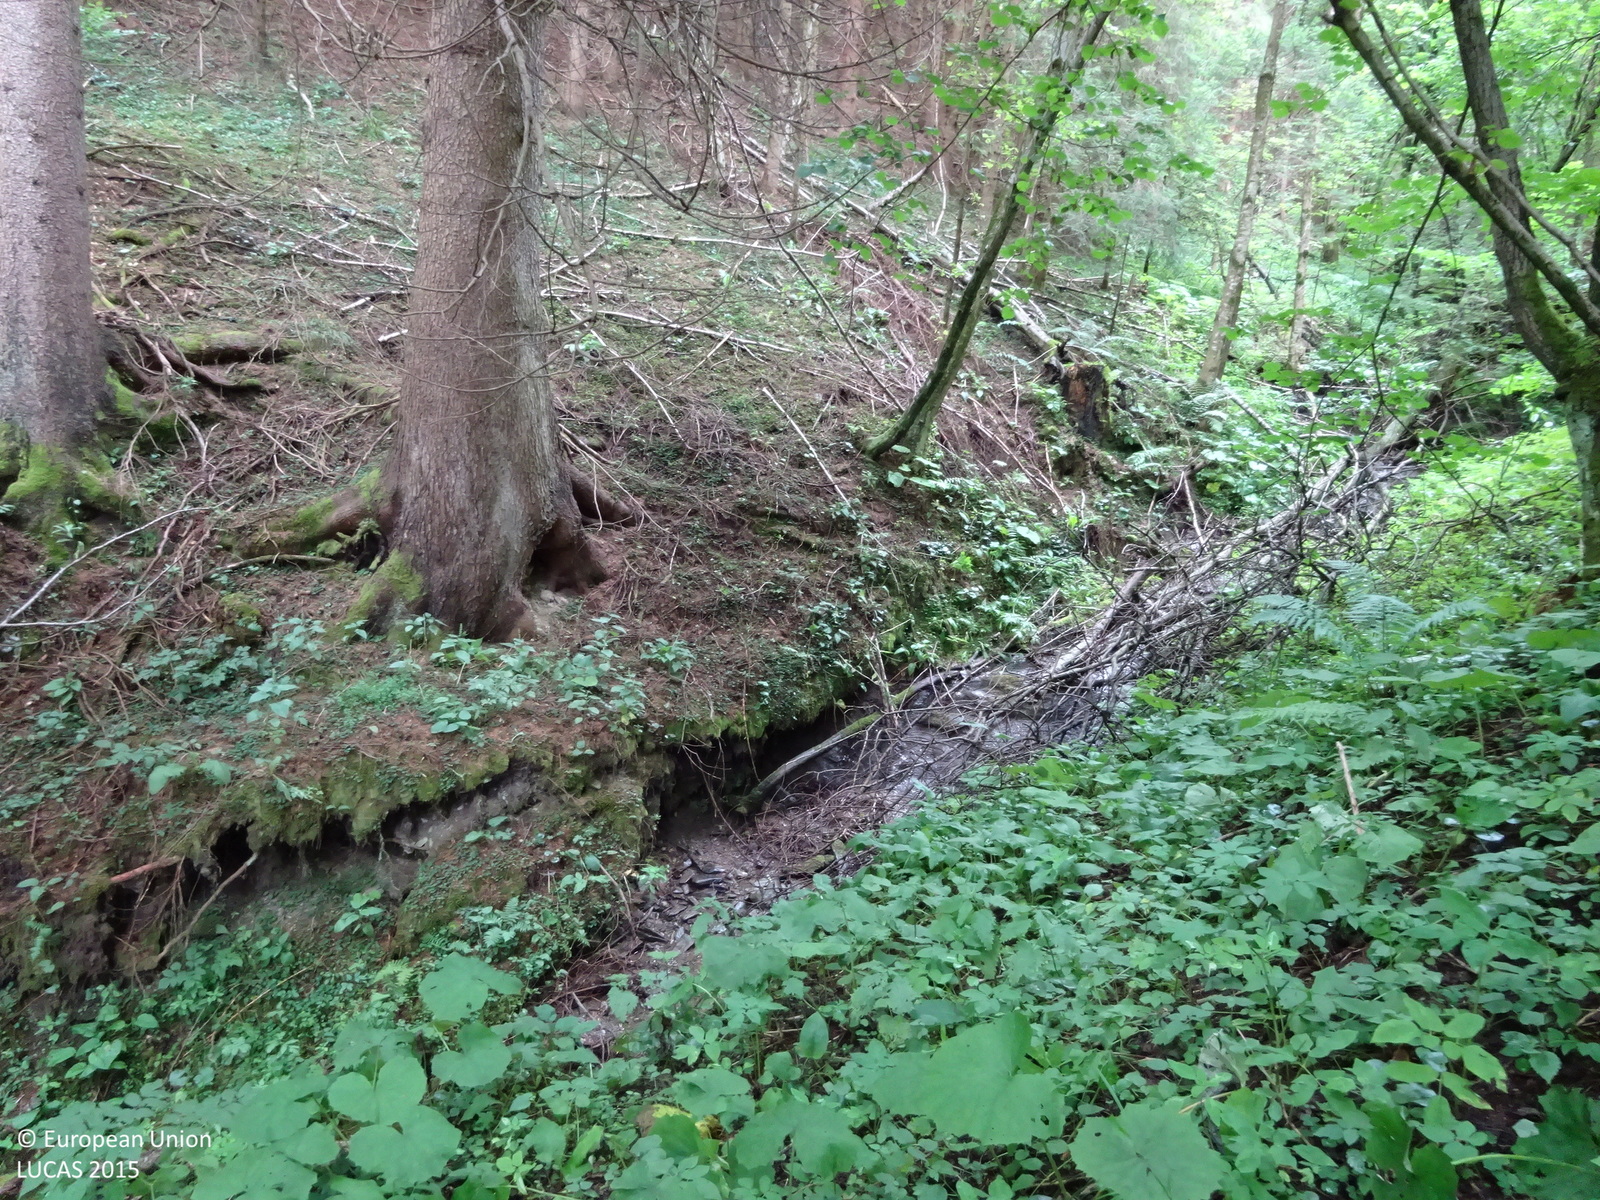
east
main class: Woodland
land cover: Spruce dominated mixed woodland
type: mountainous beech forest
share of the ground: > 75 %
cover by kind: broadleaved forest trees 65 %, coniferous forest trees 25 %, shrubs 10 %
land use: Forestry
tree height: > 5 m
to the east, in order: Spruce dominated mixed woodland; Rivers and streams; Spruce dominated coniferous woodland; Tracks; Broadleaved woodland; Grassland without tree/shrub cover; Shrubland with sparse tree cover; Grassland without tree/shrub cover; Paved roads, cycling and walking lanes; Grassland without tree/shrub cover
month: July
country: AT
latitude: 47.2380
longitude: 15.5089
